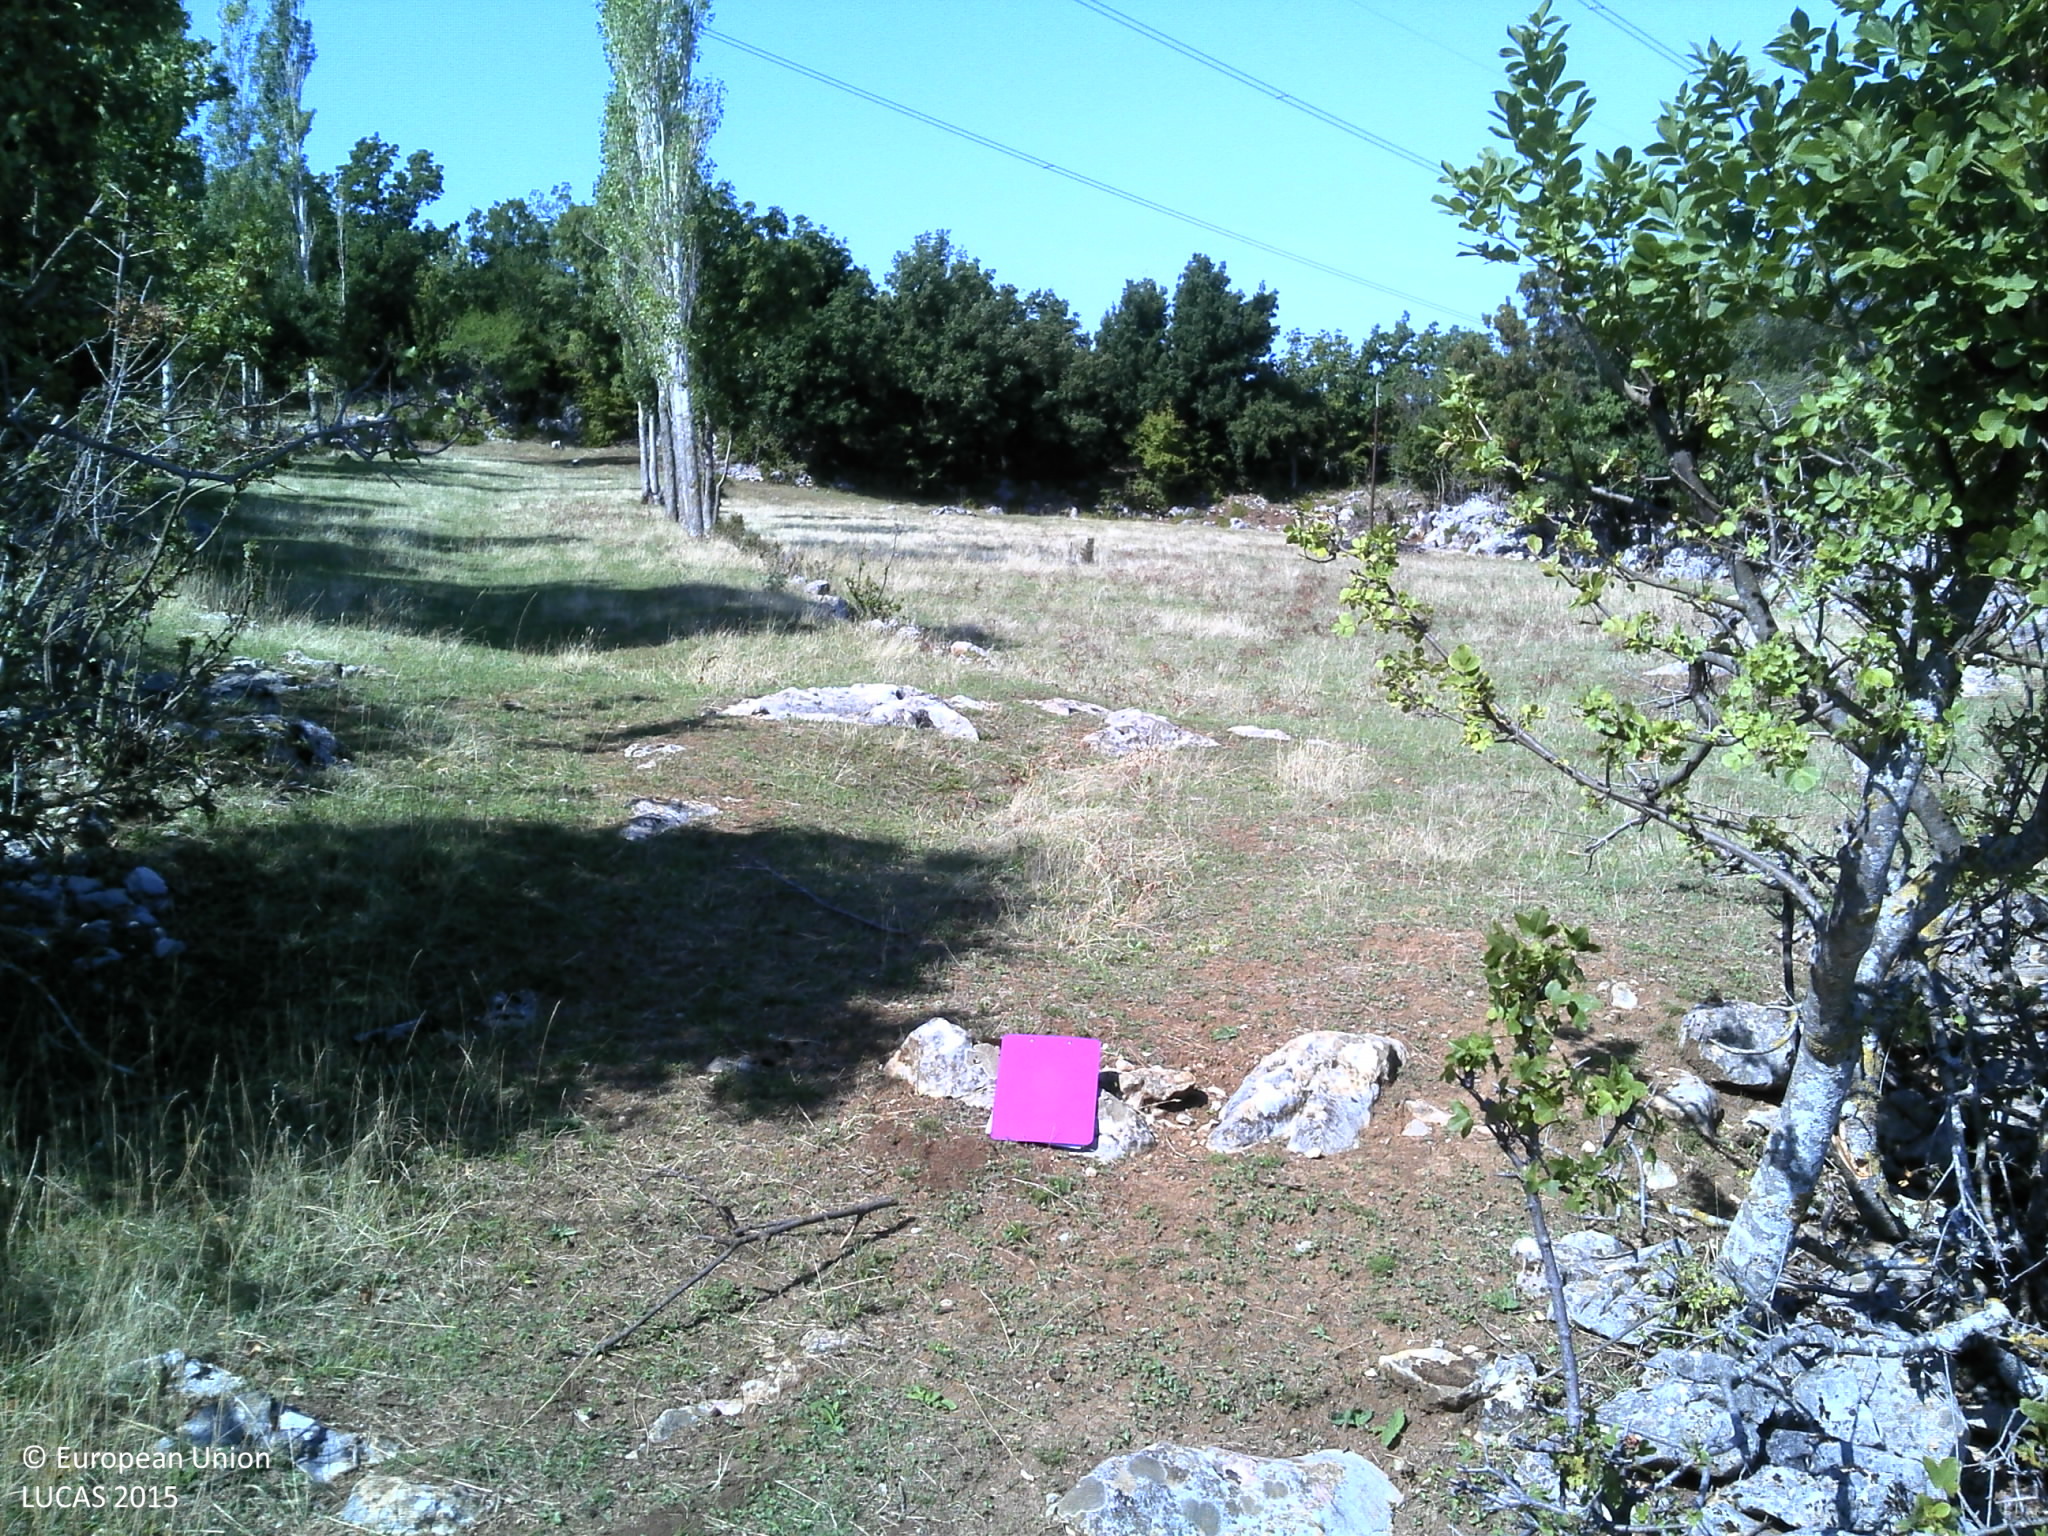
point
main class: Grassland
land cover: Grassland with sparse tree/shrub cover
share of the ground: 50 - 75 %
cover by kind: herbaceous plants 75 %, shrubs 10 %, broadleaved forest trees 5 %, consolidated bare surface 5 %, unconsolidated bare surface 5 %
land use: Agriculture (excluding fallow land and kitchen gardens)
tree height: > 5 m
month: August
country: HR
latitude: 44.2043
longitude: 15.8367
